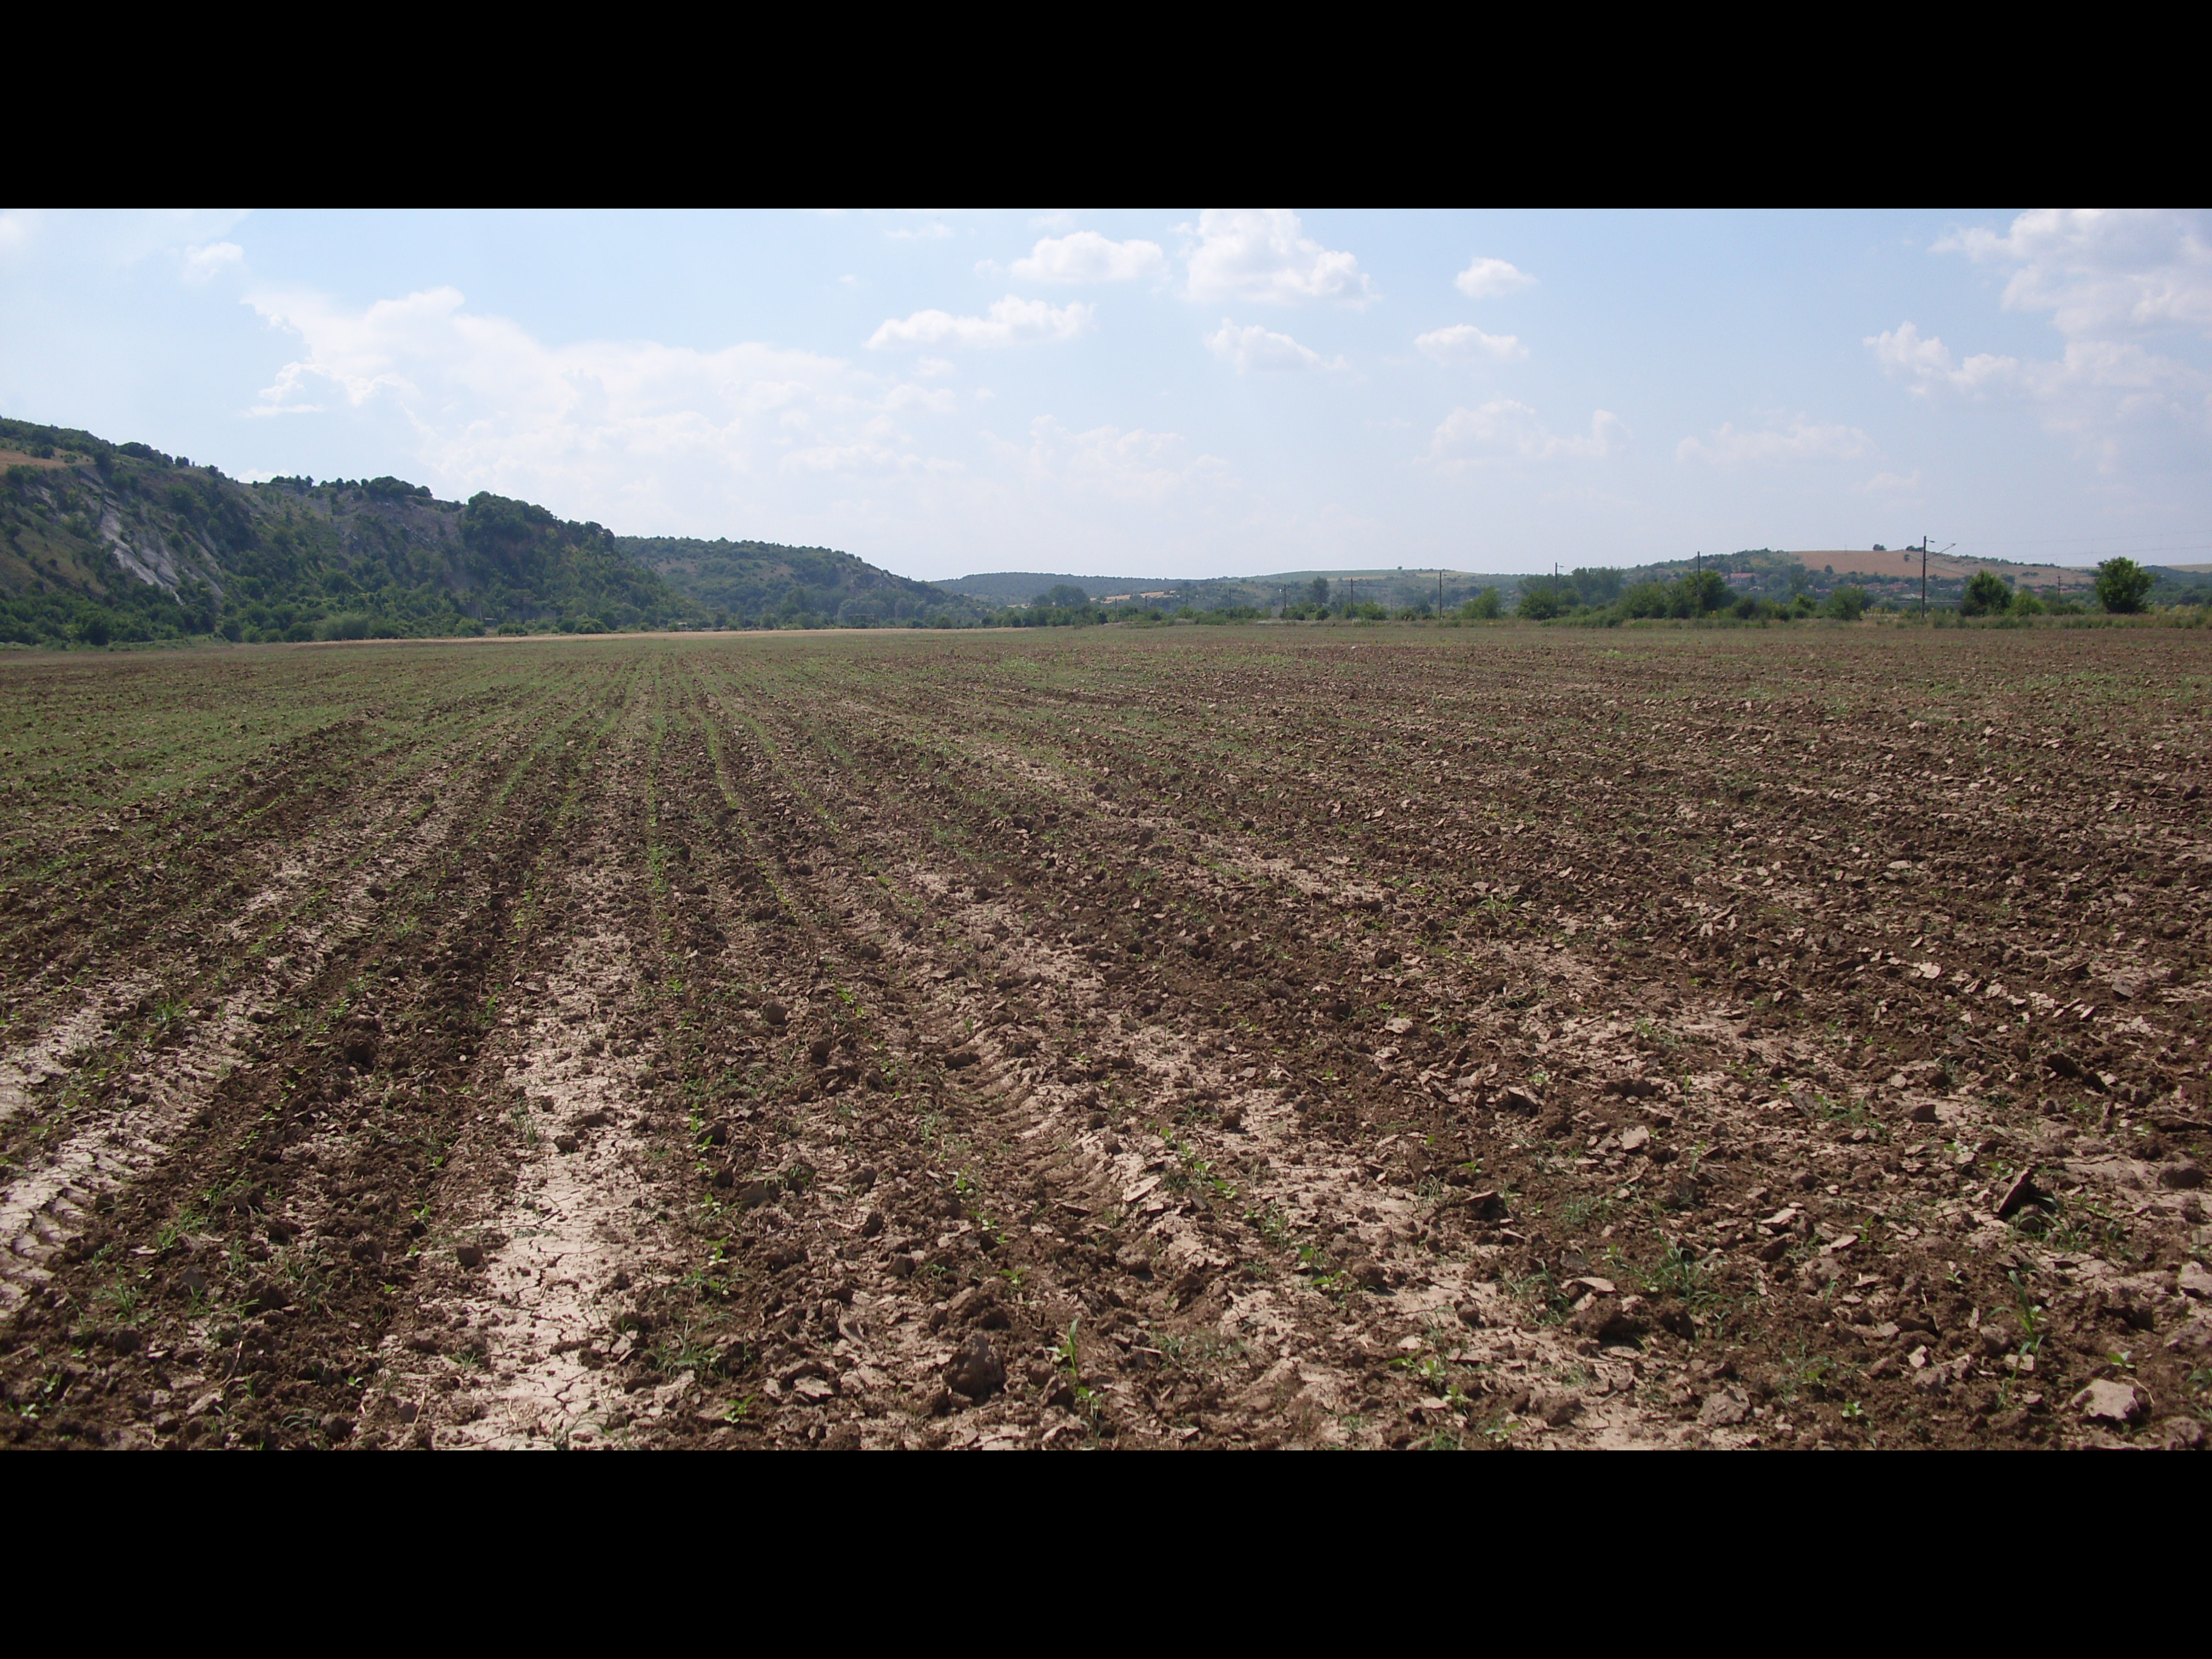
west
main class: Cropland
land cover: Sunflower
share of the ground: < 10 %
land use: Agriculture (excluding fallow land and kitchen gardens)
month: June
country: BG
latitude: 43.4711
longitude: 23.3054
